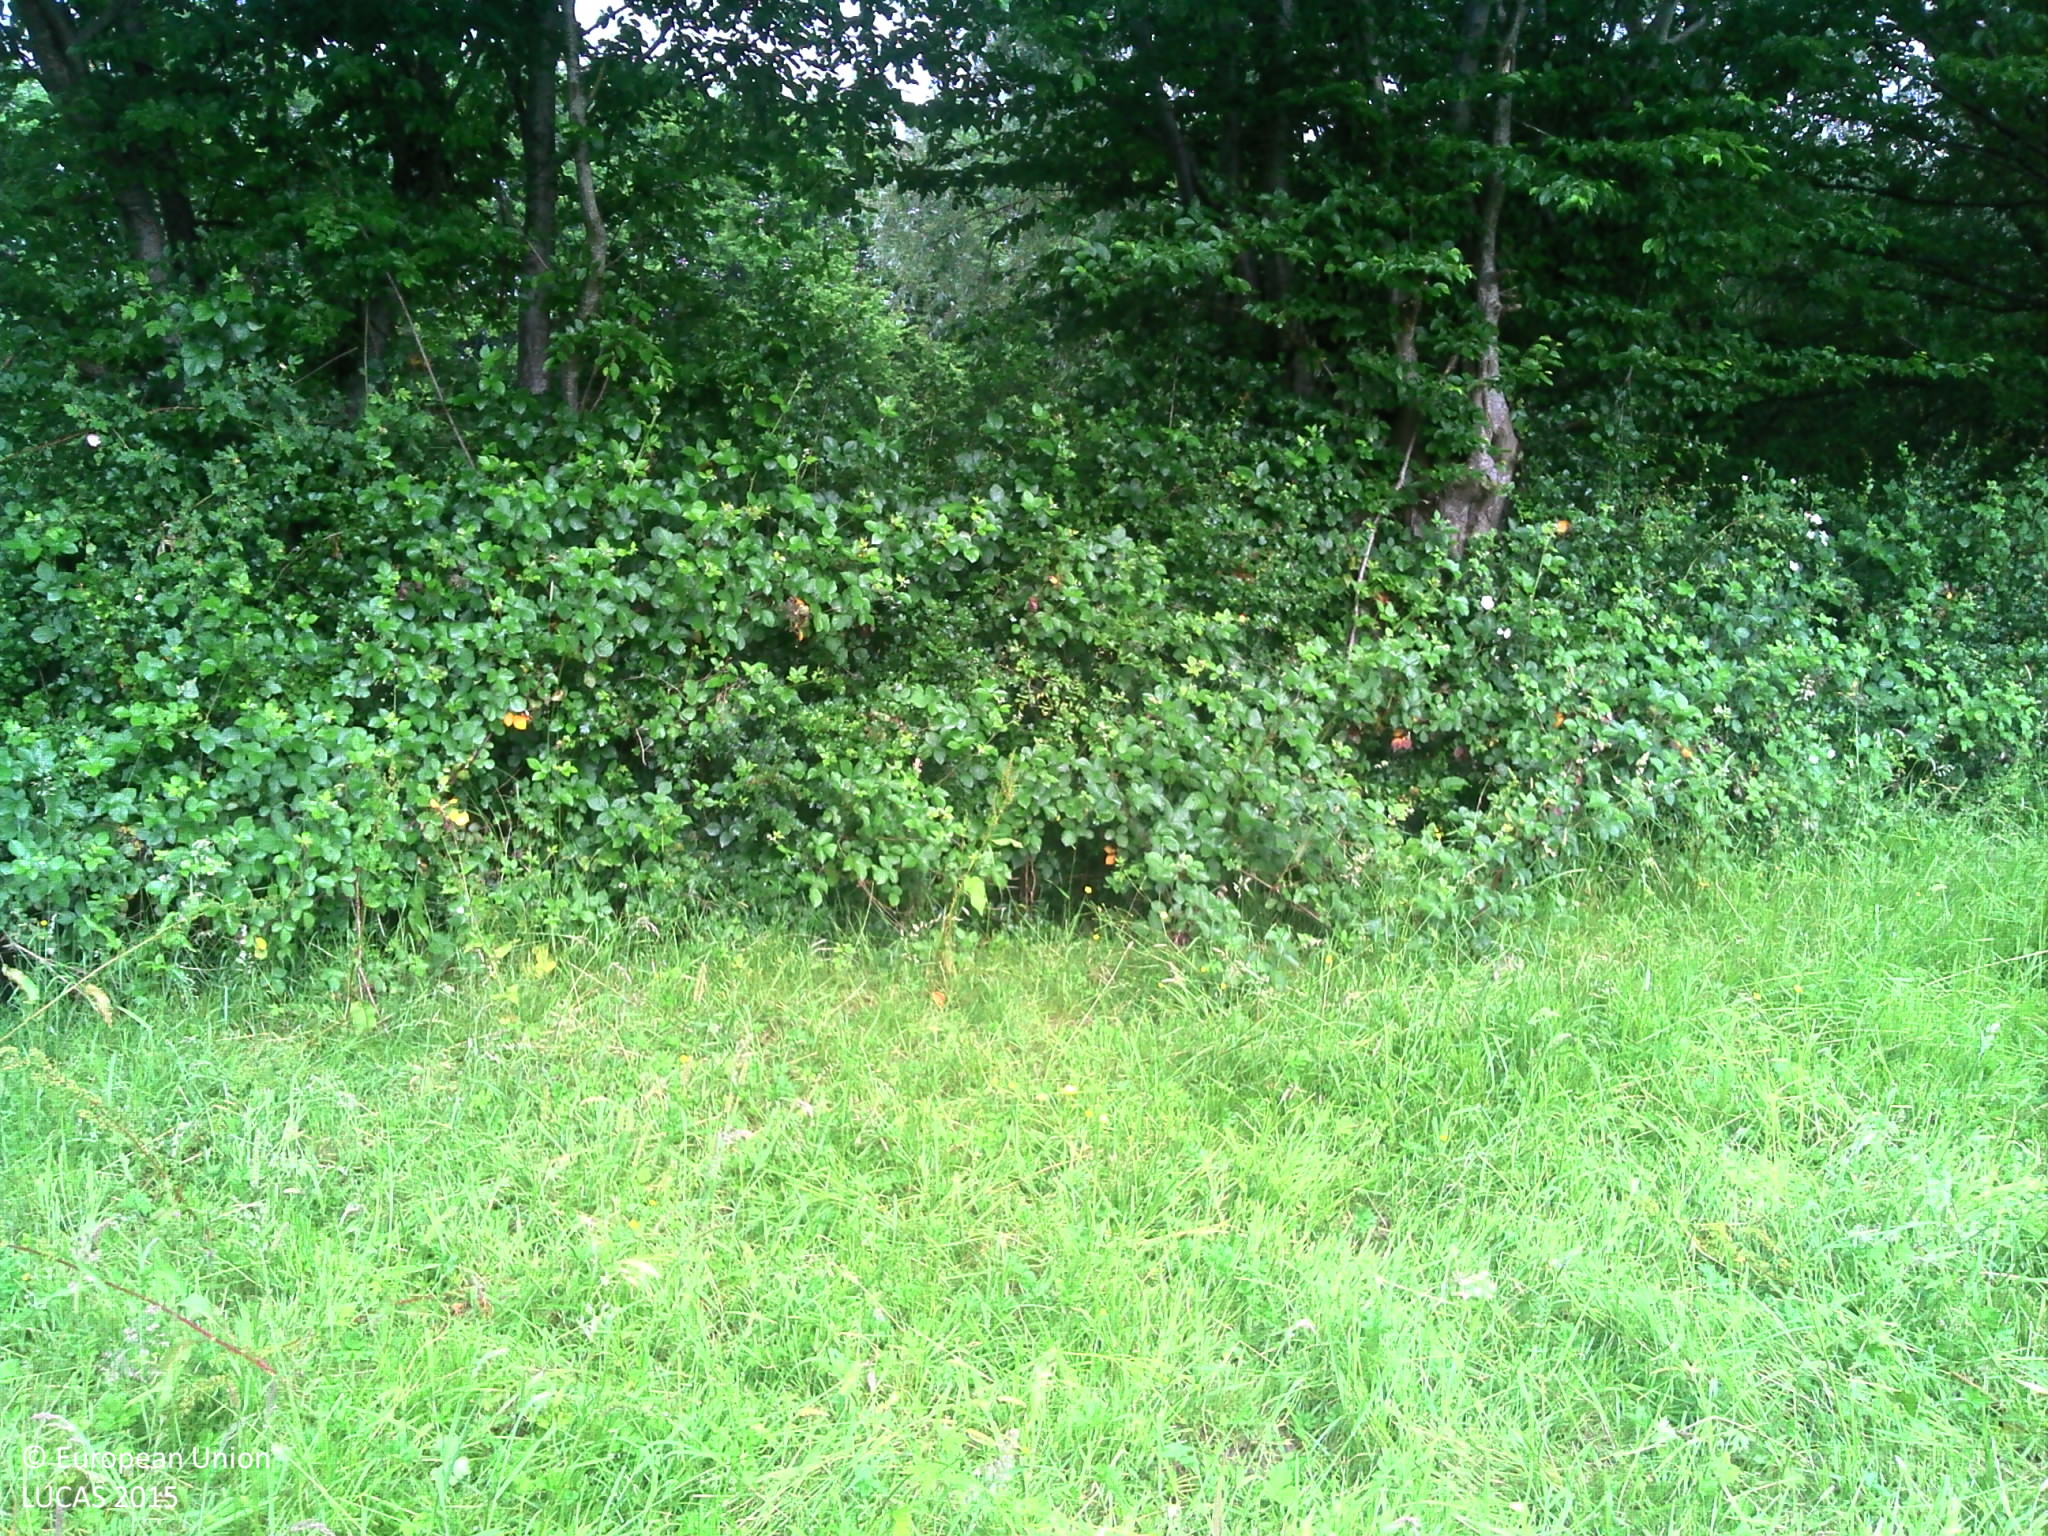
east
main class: Grassland
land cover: Grassland without tree/shrub cover
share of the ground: > 75 %
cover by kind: herbaceous plants 100 %
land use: Agriculture (excluding fallow land and kitchen gardens)
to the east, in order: Grassland without tree/shrub cover; Broadleaved woodland; Fences; Grassland without tree/shrub cover; Fences; Abandoned hedges; Tracks; Abandoned hedges; Fences; Grassland without tree/shrub cover; Fences; Grassland without tree/shrub cover; Fences; Spontaneously vegetated surfaces; Grassland without tree/shrub cover
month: June
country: FR
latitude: 49.9176
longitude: 3.9918
